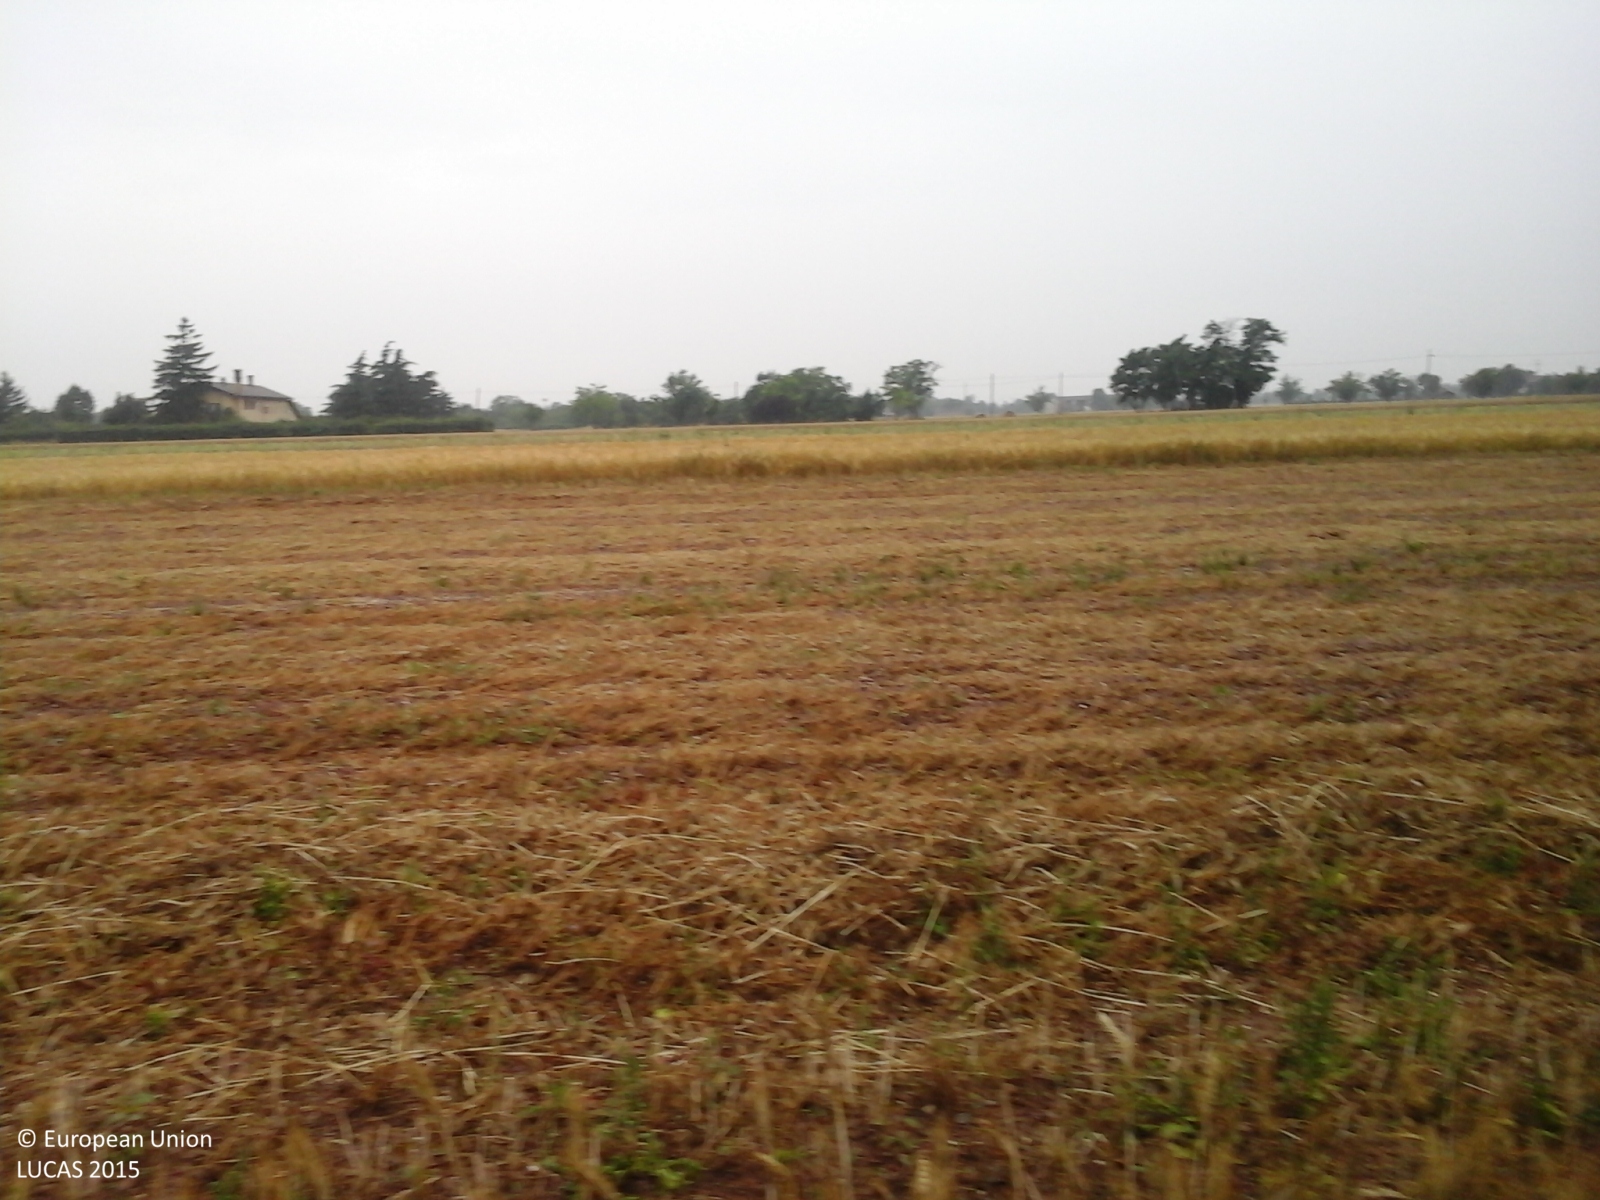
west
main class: Cropland
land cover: Common wheat
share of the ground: > 75 %
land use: Agriculture (excluding fallow land and kitchen gardens)
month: June
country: IT
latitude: 44.8128
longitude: 8.8264
